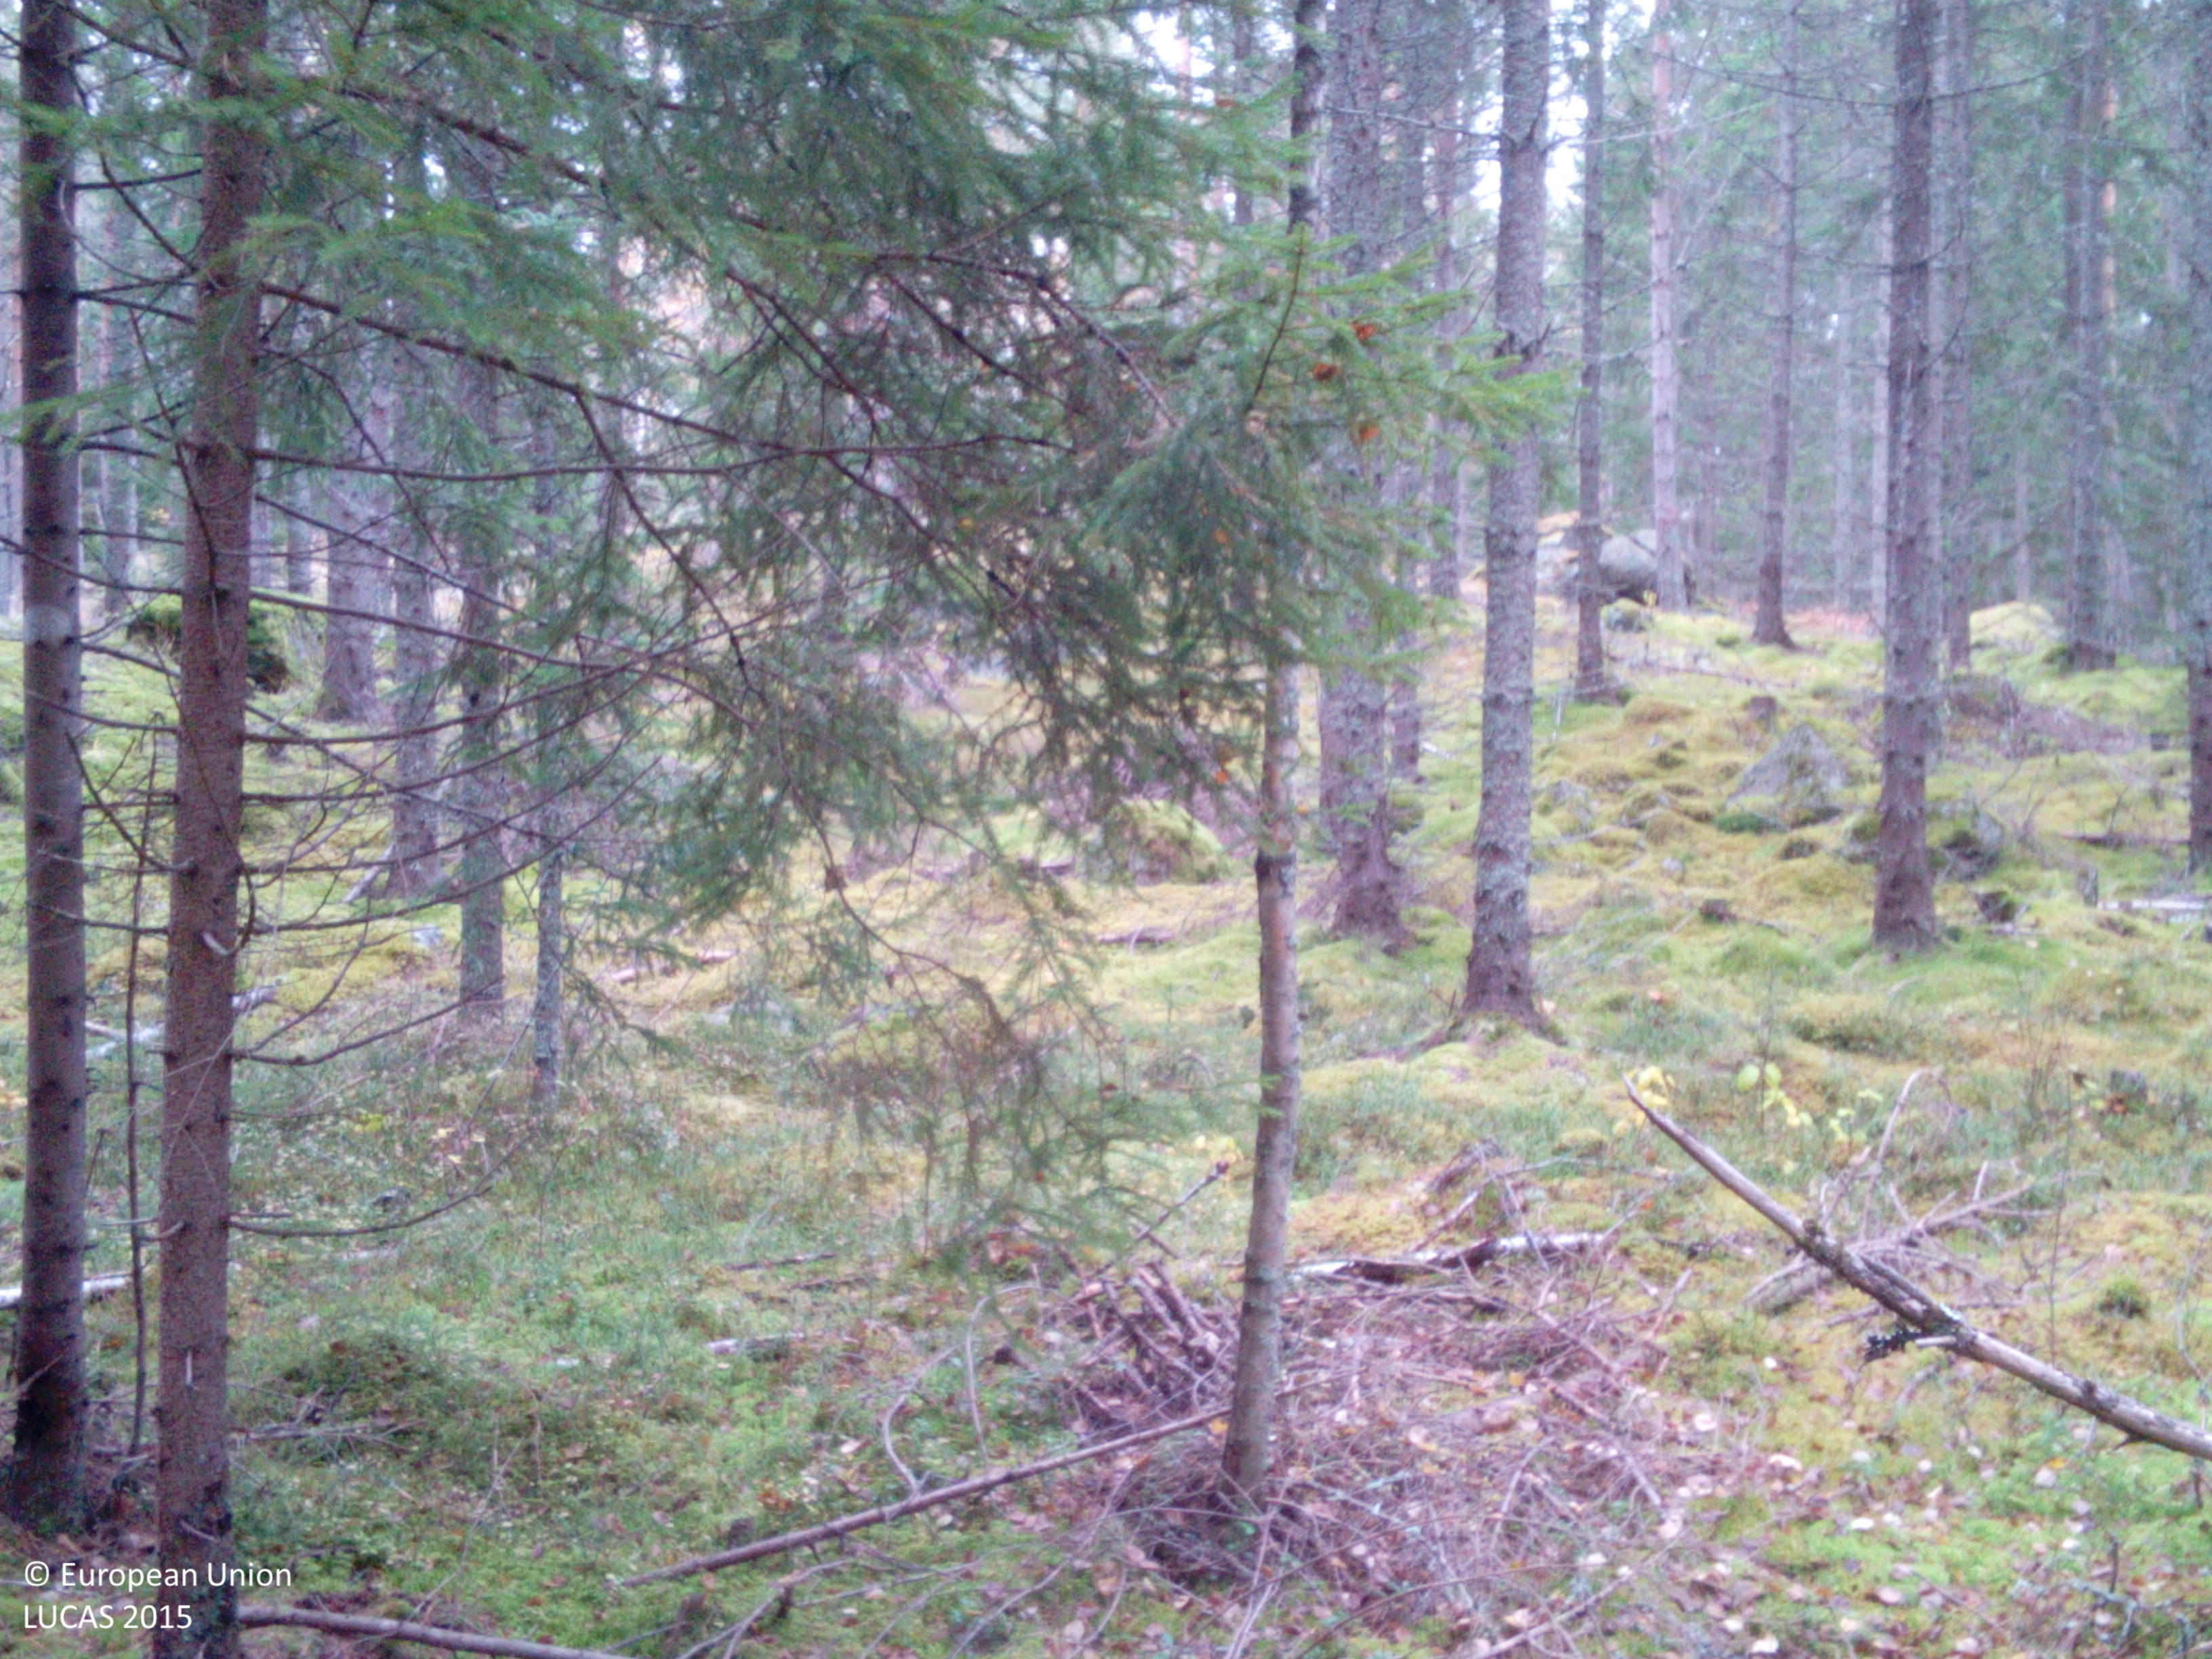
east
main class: Woodland
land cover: Spruce dominated coniferous woodland
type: boreal forest
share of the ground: > 75 %
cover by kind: coniferous forest trees 85 %, lichens and mosses 10 %, herbaceous plants 5 %
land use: Forestry
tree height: > 5 m
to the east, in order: Spruce dominated coniferous woodland; Other coniferous woodland; Grassland without tree/shrub cover; Other mixed woodland; Tracks; Dry stone walls; Shruby margins; Grassland without tree/shrub cover
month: October
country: SE
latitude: 59.1937
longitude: 16.2427
